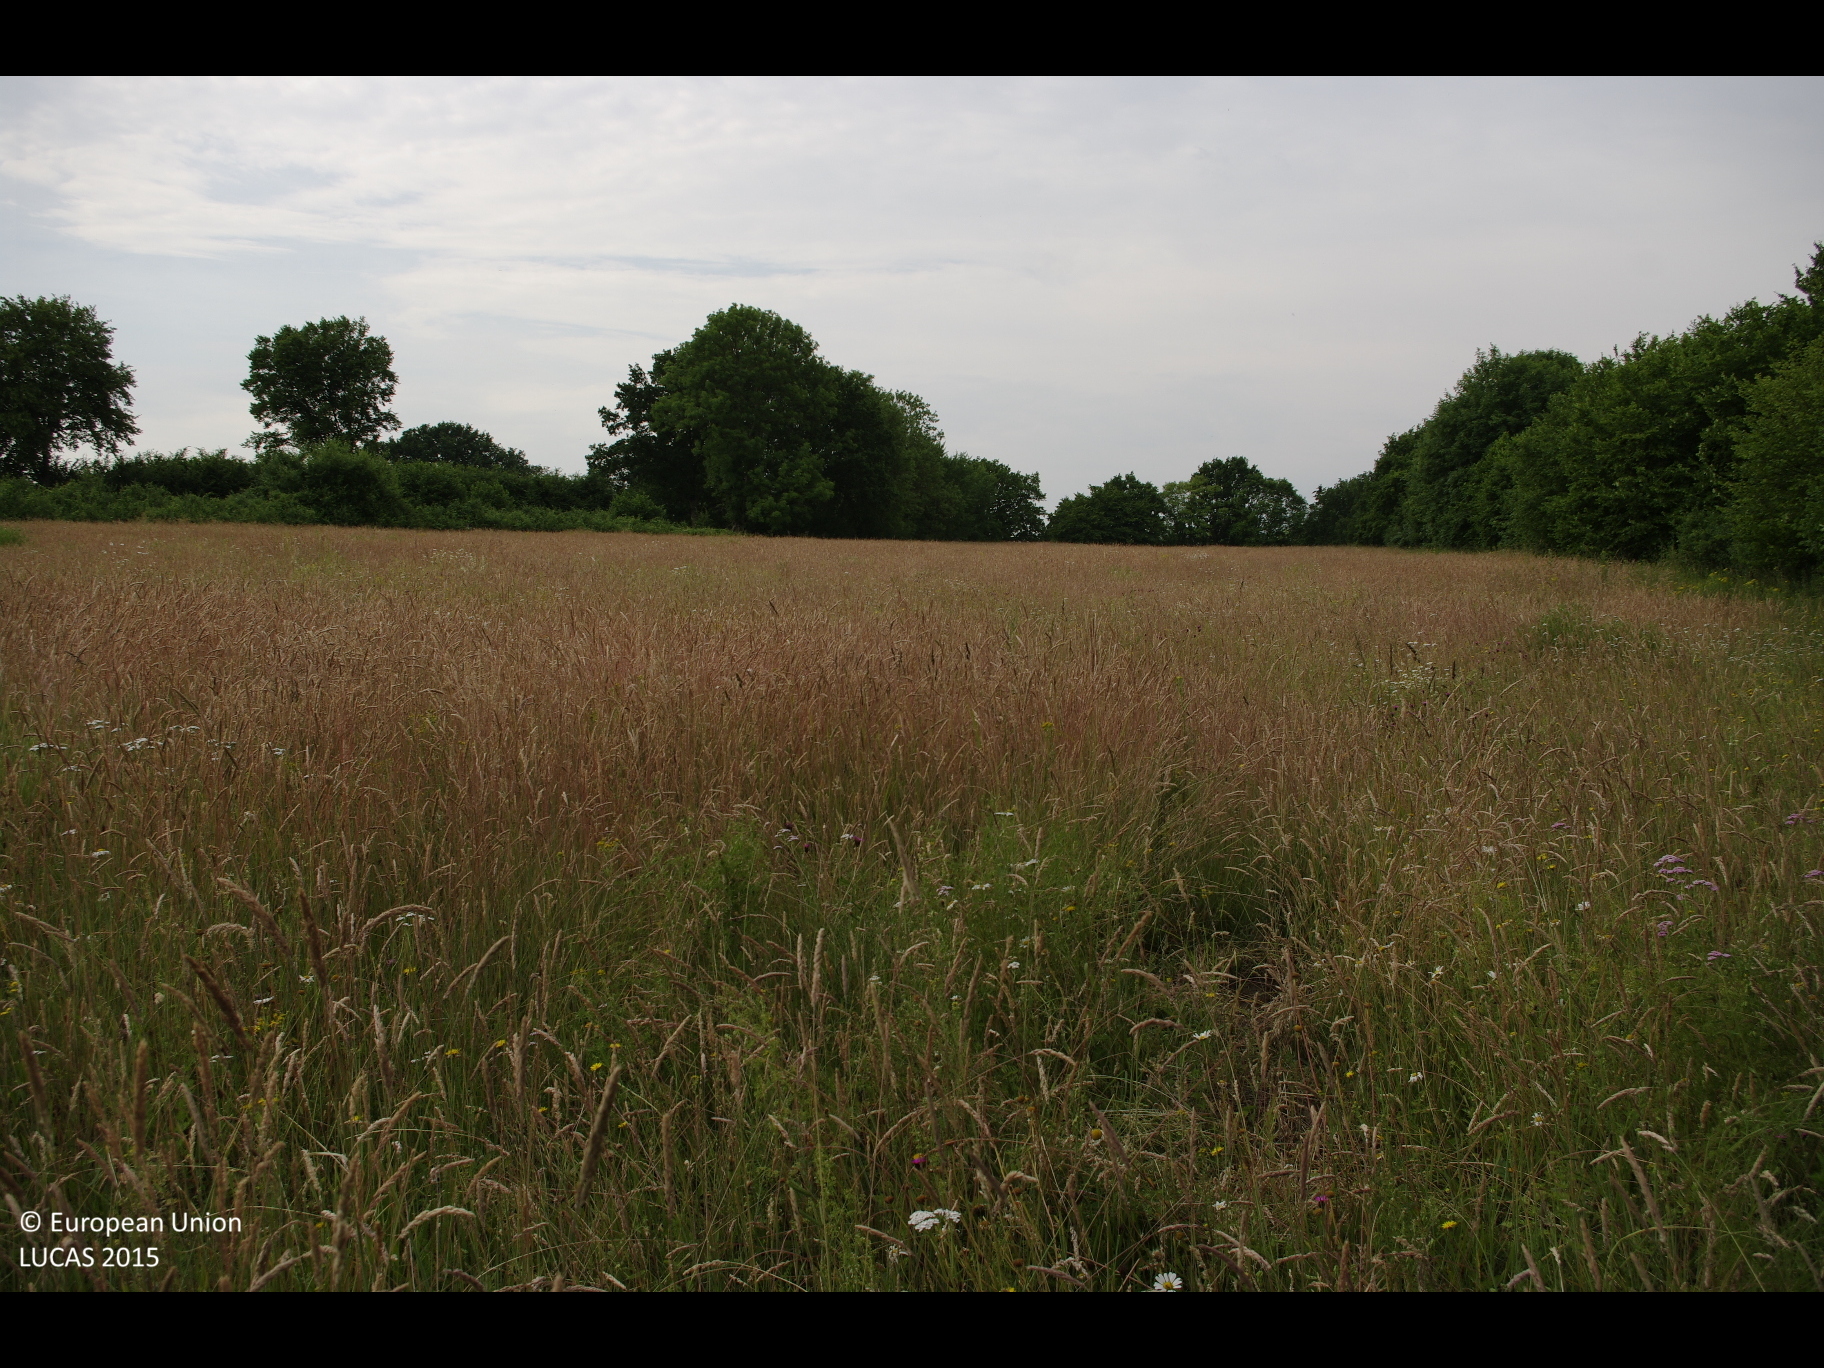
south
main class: Grassland
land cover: Grassland without tree/shrub cover
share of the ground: > 75 %
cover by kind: herbaceous plants 100 %
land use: Agriculture (excluding fallow land and kitchen gardens)
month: July
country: DE
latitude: 53.8317
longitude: 10.6226
